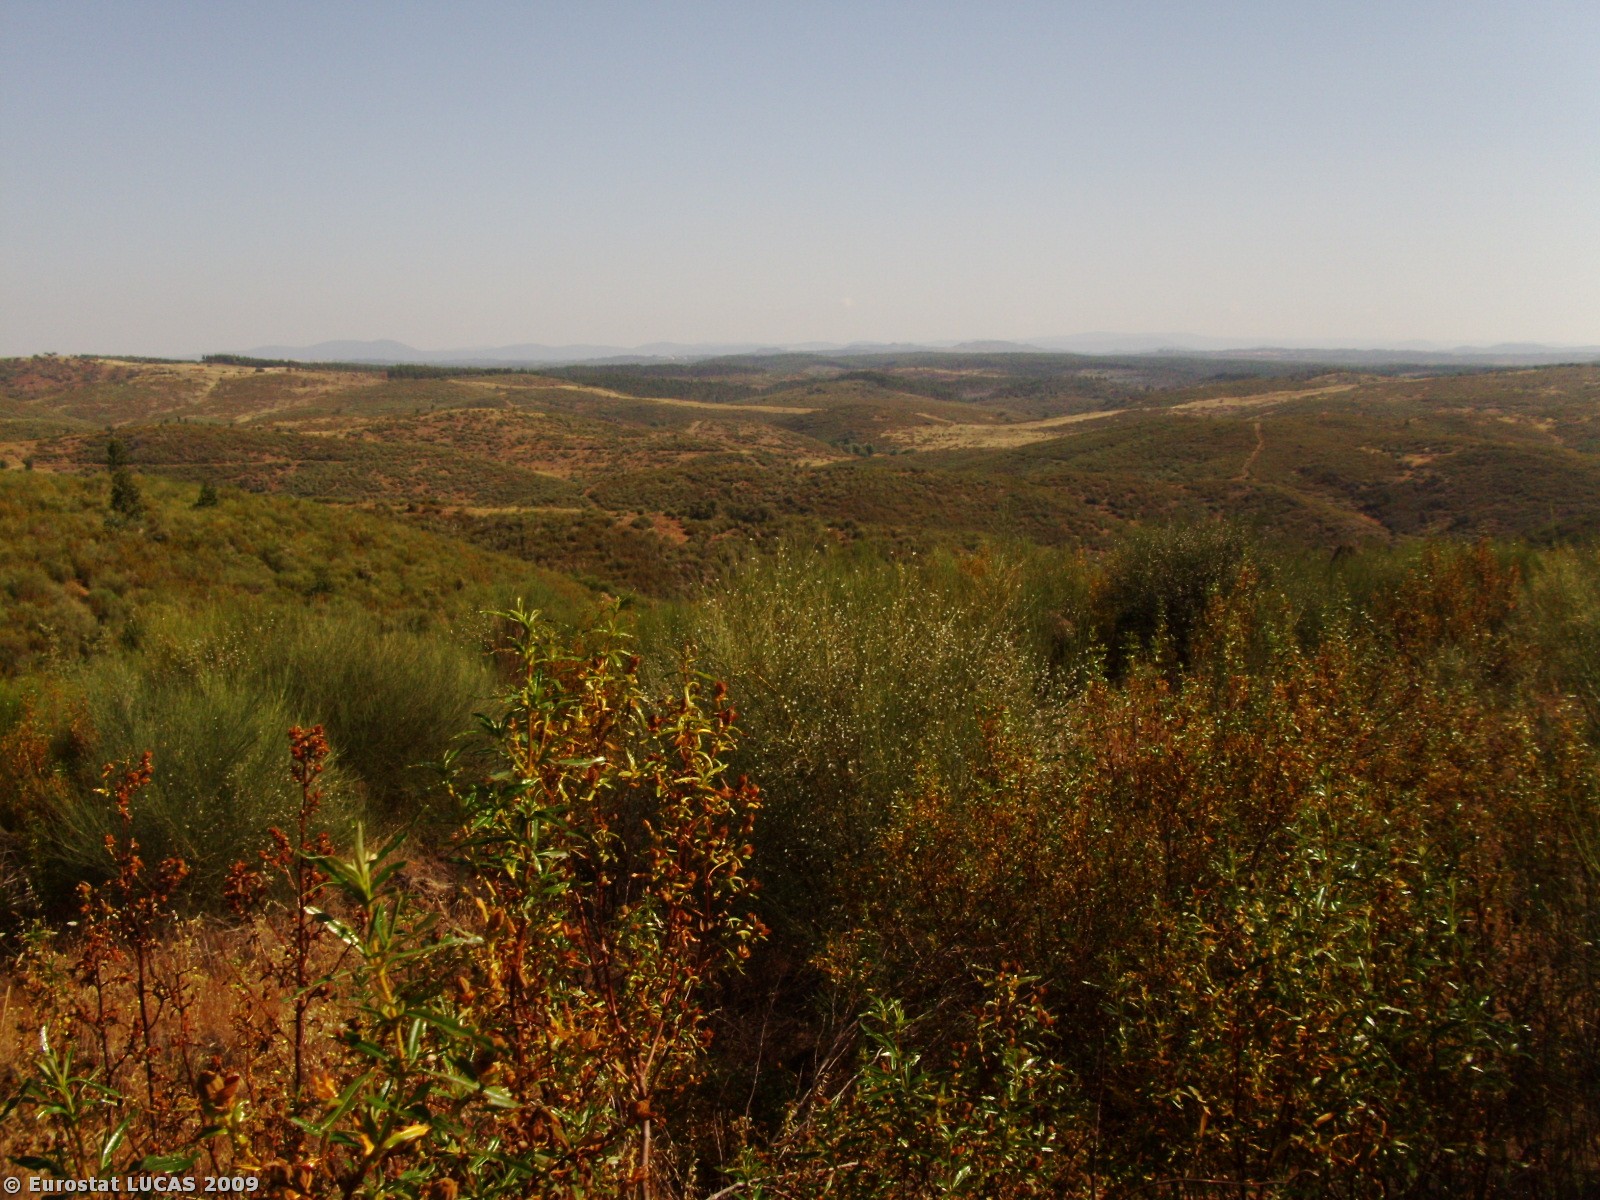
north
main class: Shrubland
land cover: Shrubland with sparse tree cover
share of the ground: > 75 %
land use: Unused
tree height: > 5 m
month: June
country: PT
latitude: 39.9848
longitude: -7.2282
